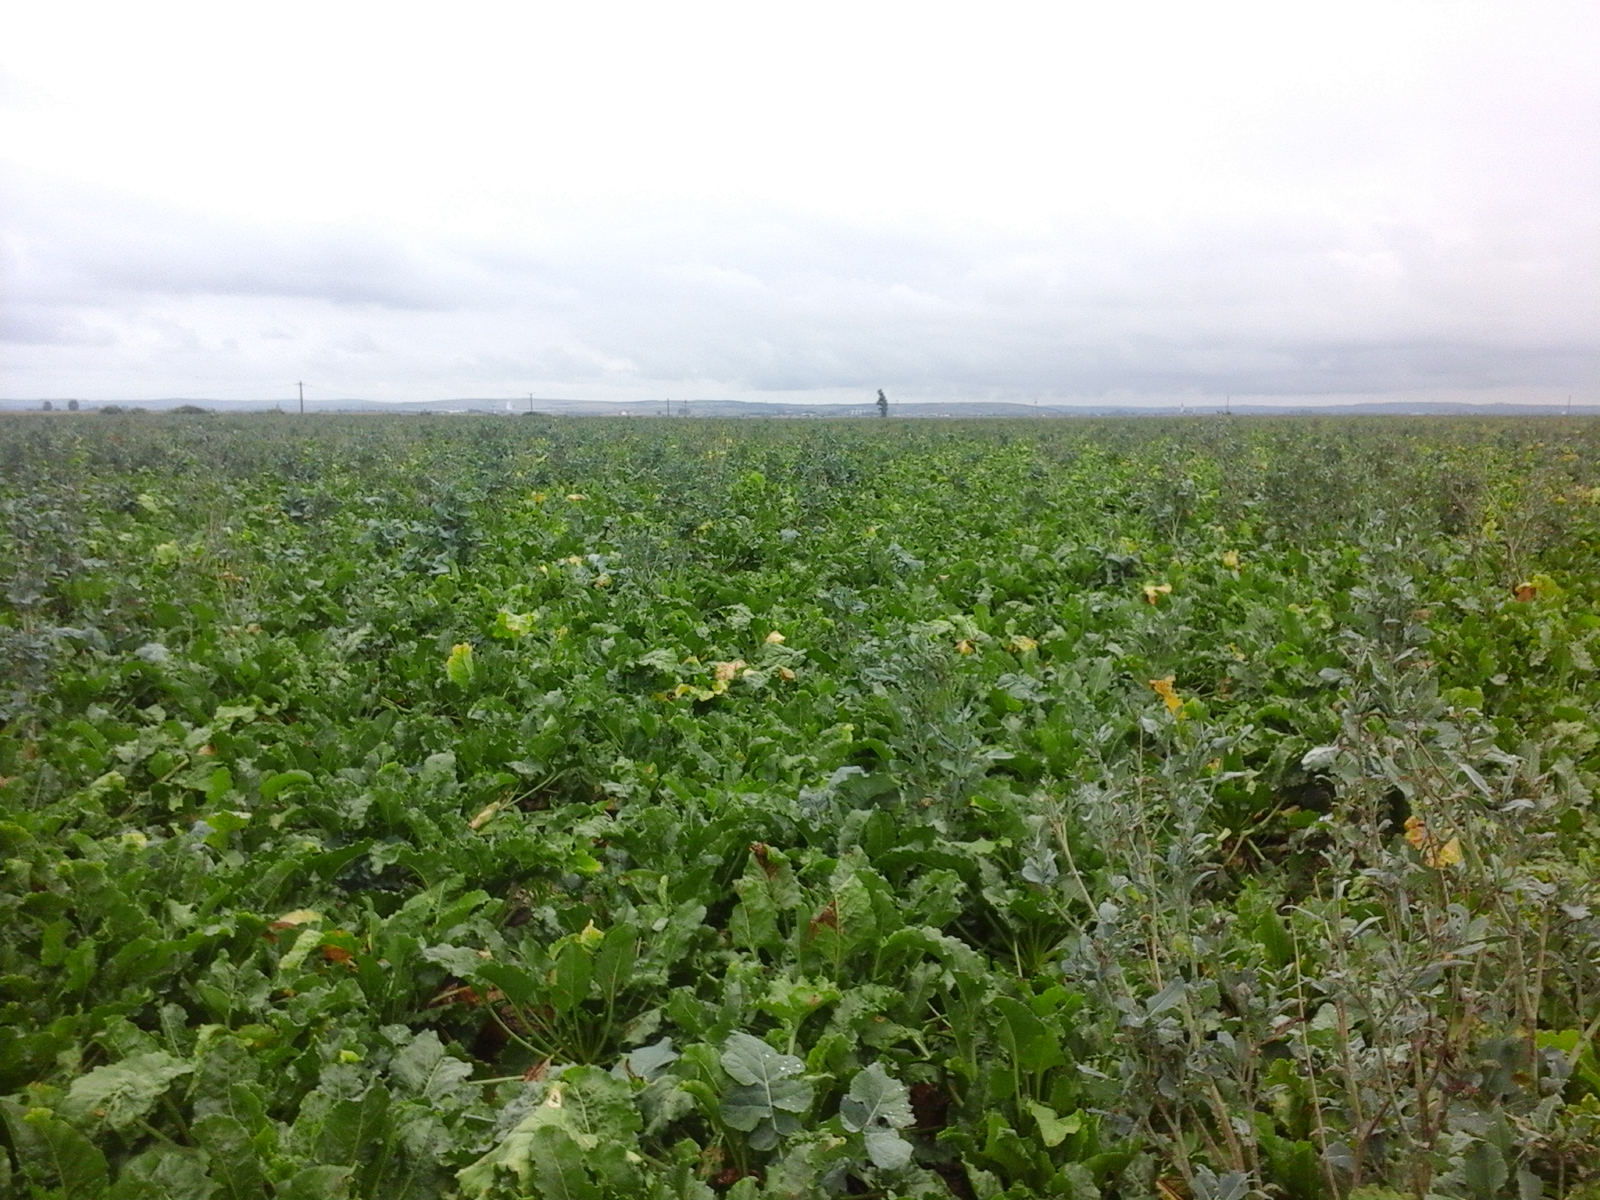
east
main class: Cropland
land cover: Sugar beet
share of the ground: > 75 %
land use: Agriculture (excluding fallow land and kitchen gardens)
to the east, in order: Sugar beet; Grass margins; Tracks; Grass margins; Abandoned hedges; Ditches and canals; Grass margins; Maize
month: September
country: RO
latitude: 47.1959
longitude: 21.8863
